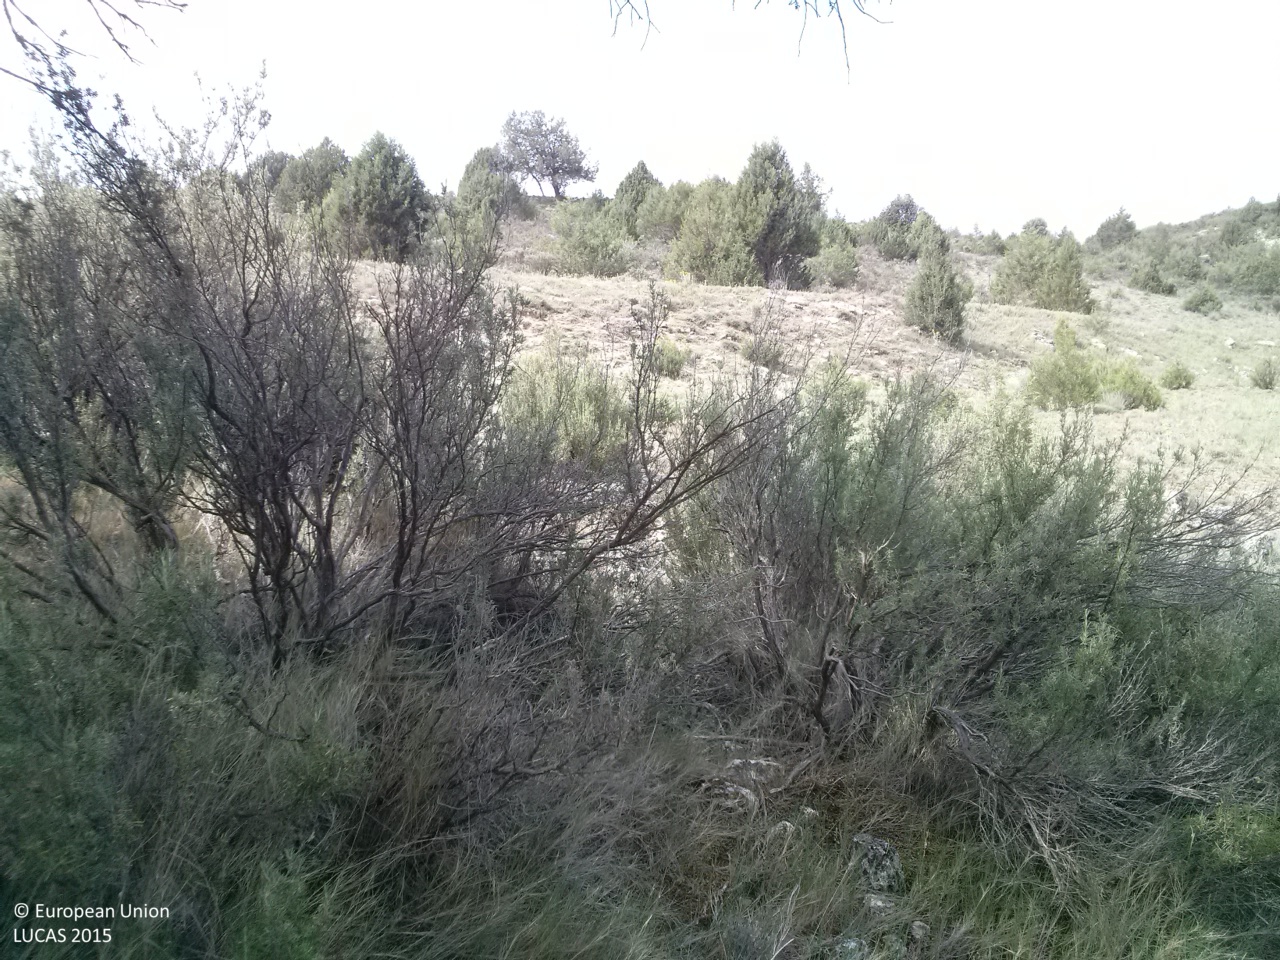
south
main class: Woodland
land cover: Other coniferous woodland
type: coniferous forest of the mediterranean region
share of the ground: 10 - 25 %
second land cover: Shrubland without tree cover
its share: 50 - 75 %
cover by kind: shrubs 60 %, coniferous forest trees 20 %, herbaceous plants 20 %
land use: Forestry
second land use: Agriculture (excluding fallow land and kitchen gardens)
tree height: > 5 m
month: June
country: ES
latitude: 39.9640
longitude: -1.8716
